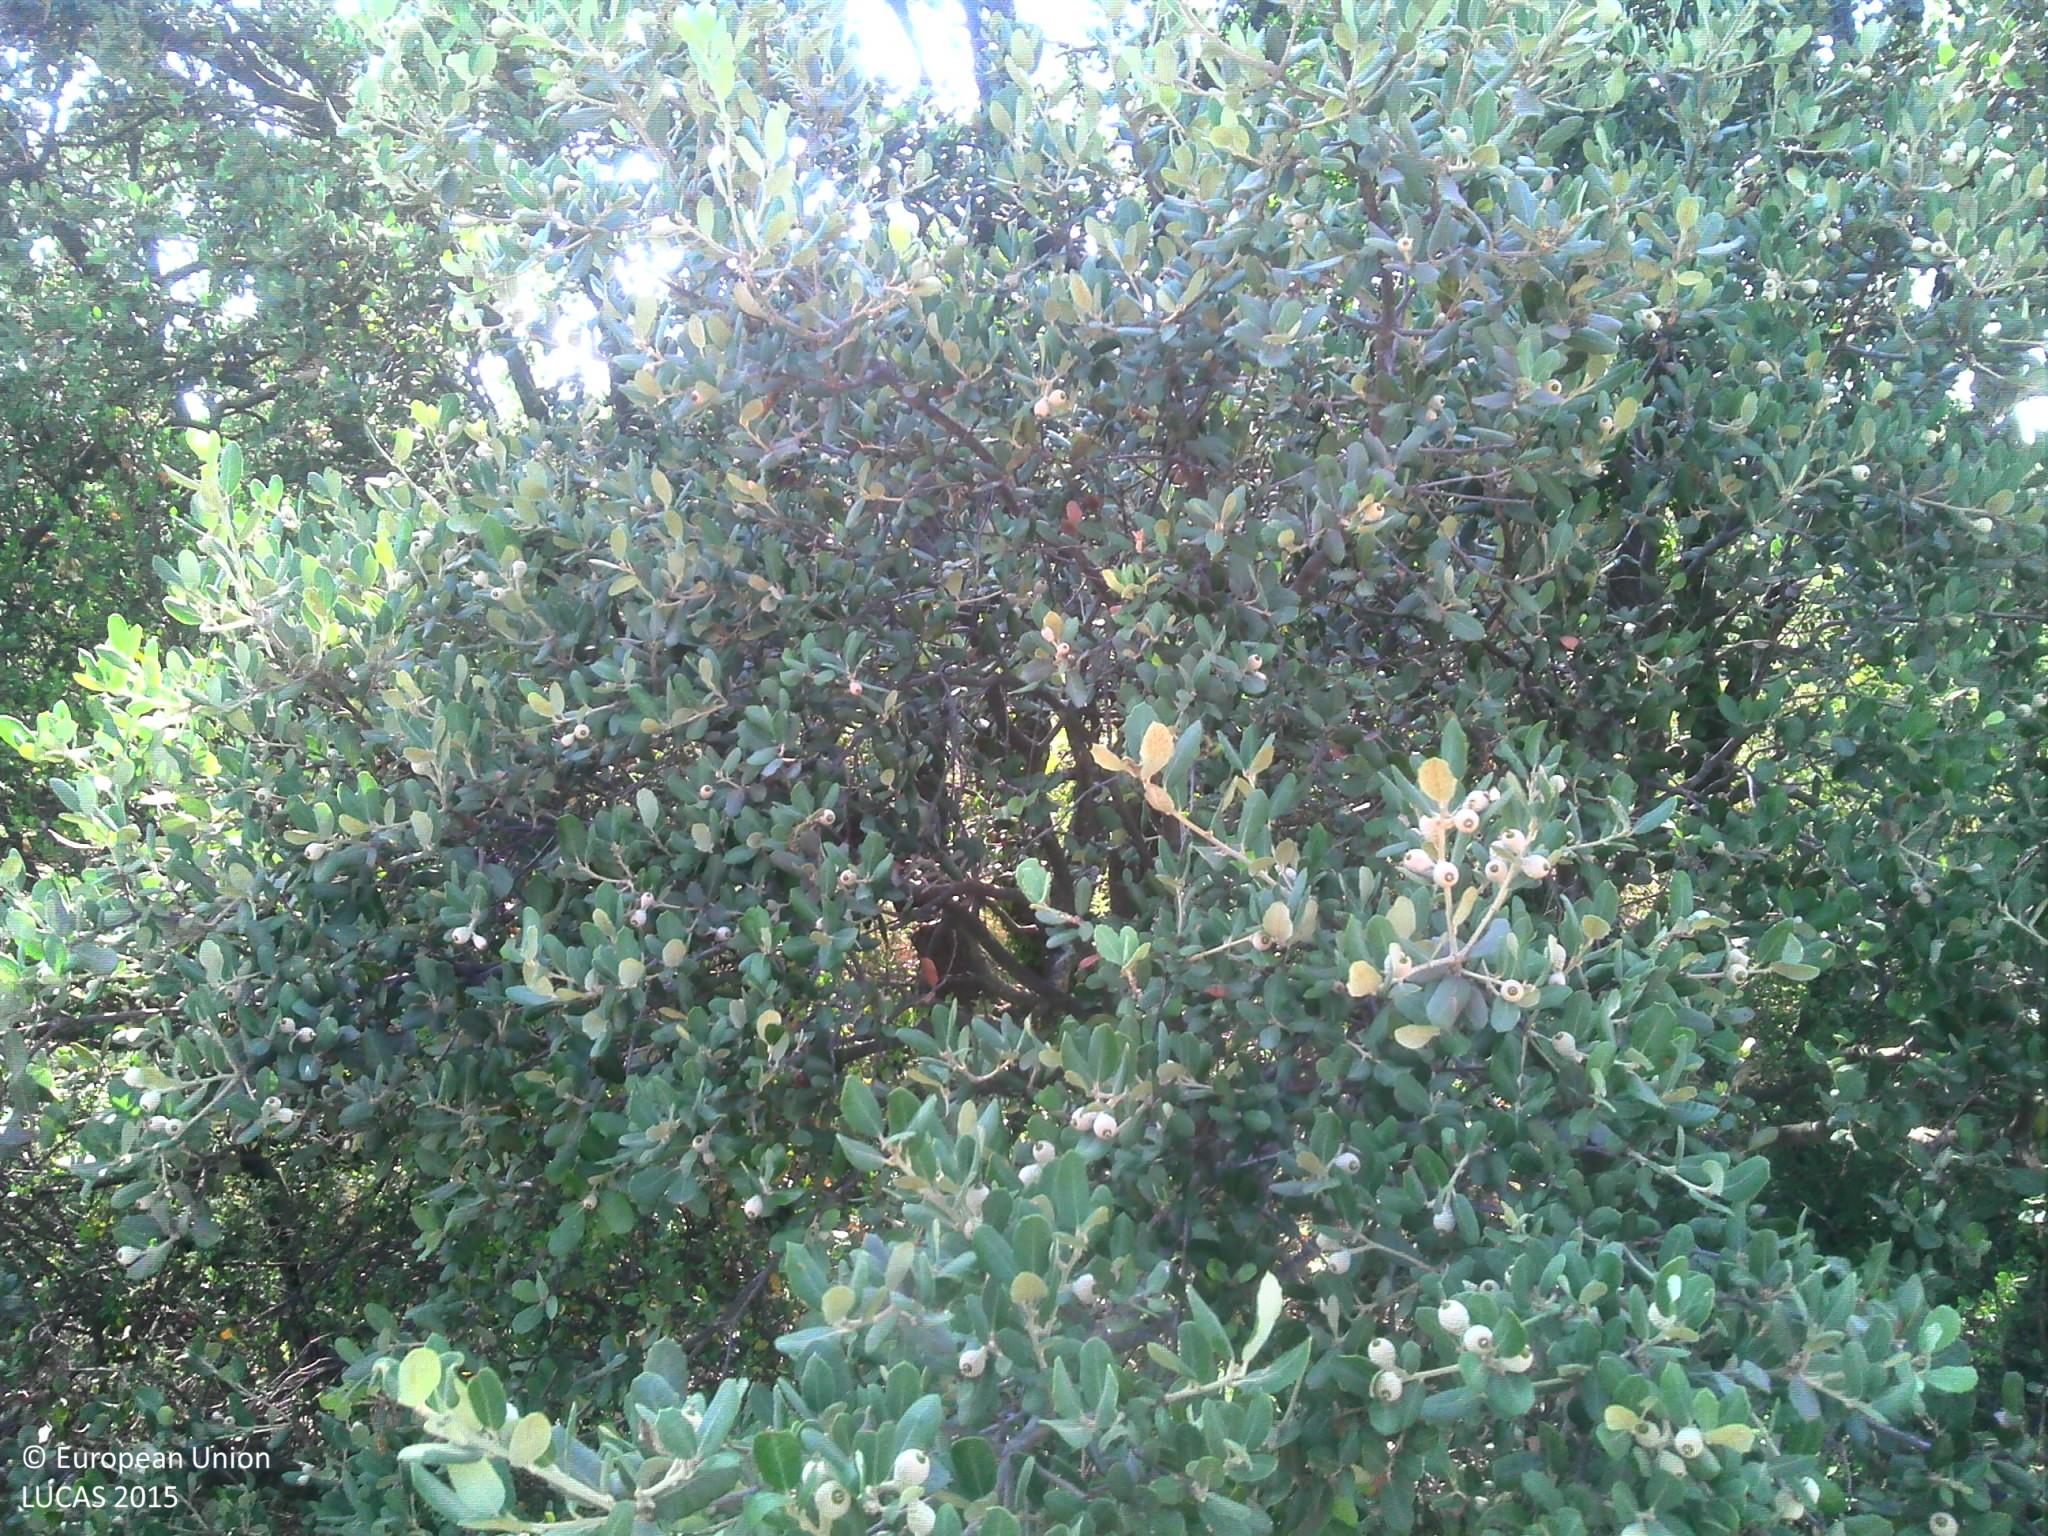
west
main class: Grassland
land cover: Grassland with sparse tree/shrub cover
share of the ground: 50 - 75 %
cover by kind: herbaceous plants 40 %, unconsolidated bare surface 40 %, lichens and mosses 10 %, broadleaved forest trees 5 %, shrubs 5 %
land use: Semi-natural and natural areas not in use
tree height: > 5 m
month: July
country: FR
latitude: 43.7291
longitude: 5.1055
